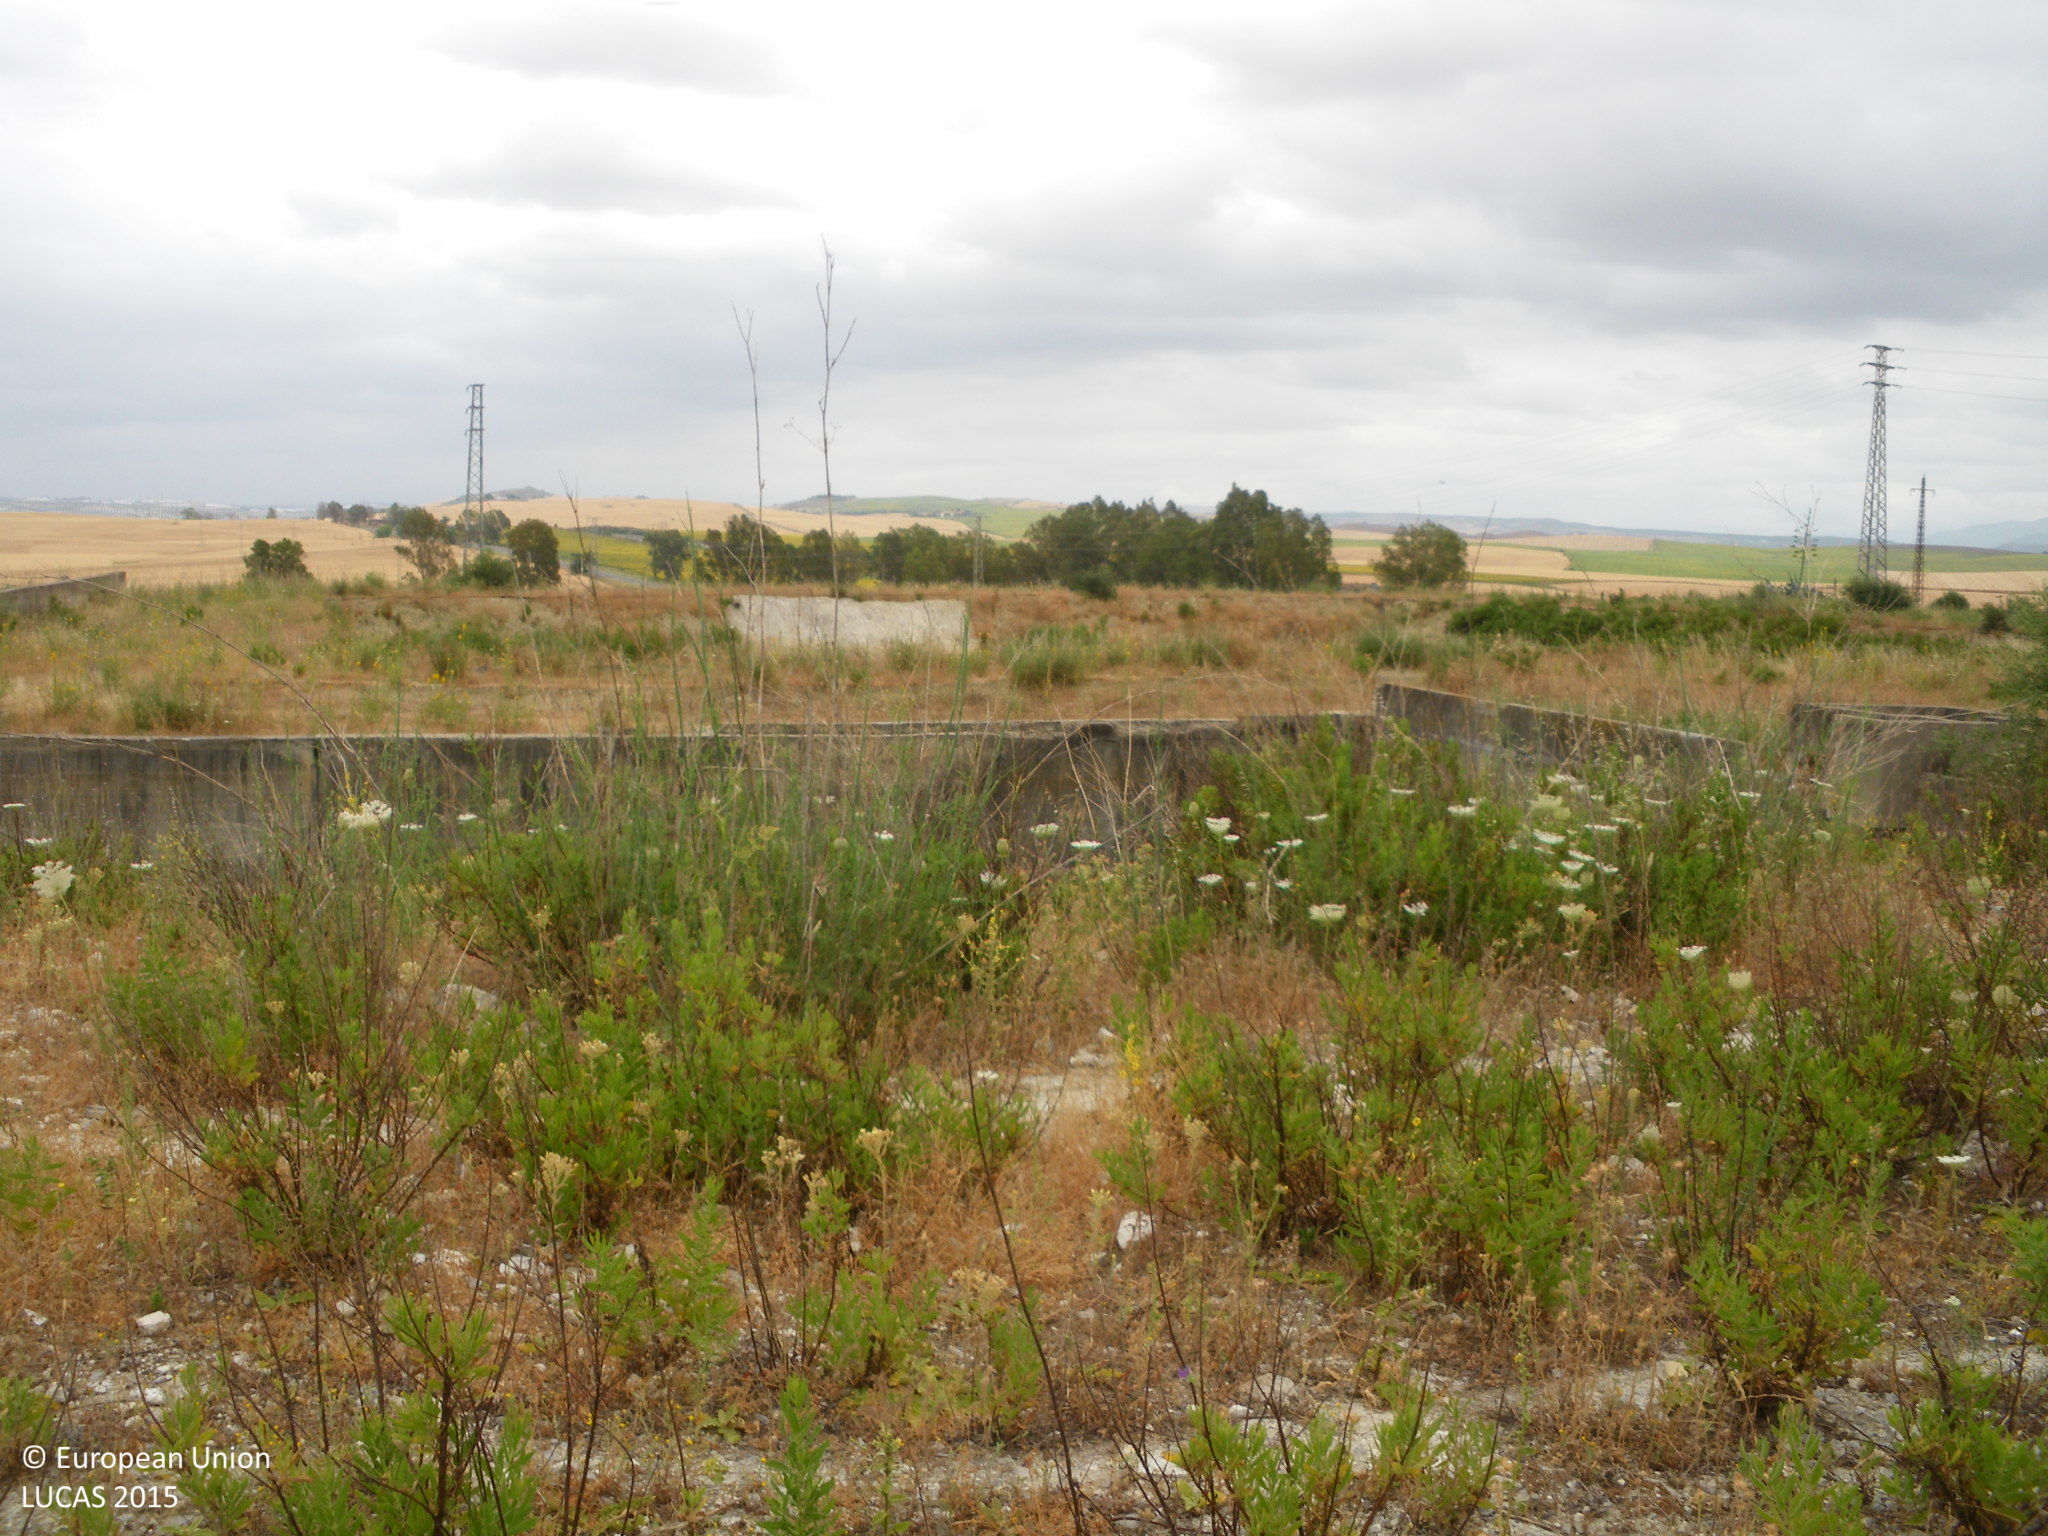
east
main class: Artificial land
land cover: Non built-up area features
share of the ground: 25 - 50 %
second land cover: Rocks and stones
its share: > 75 %
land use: Abandoned areas
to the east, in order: Spontaneously vegetated surfaces; Artificial constructions in urban areas
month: June
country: ES
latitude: 36.7288
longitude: -5.9212
